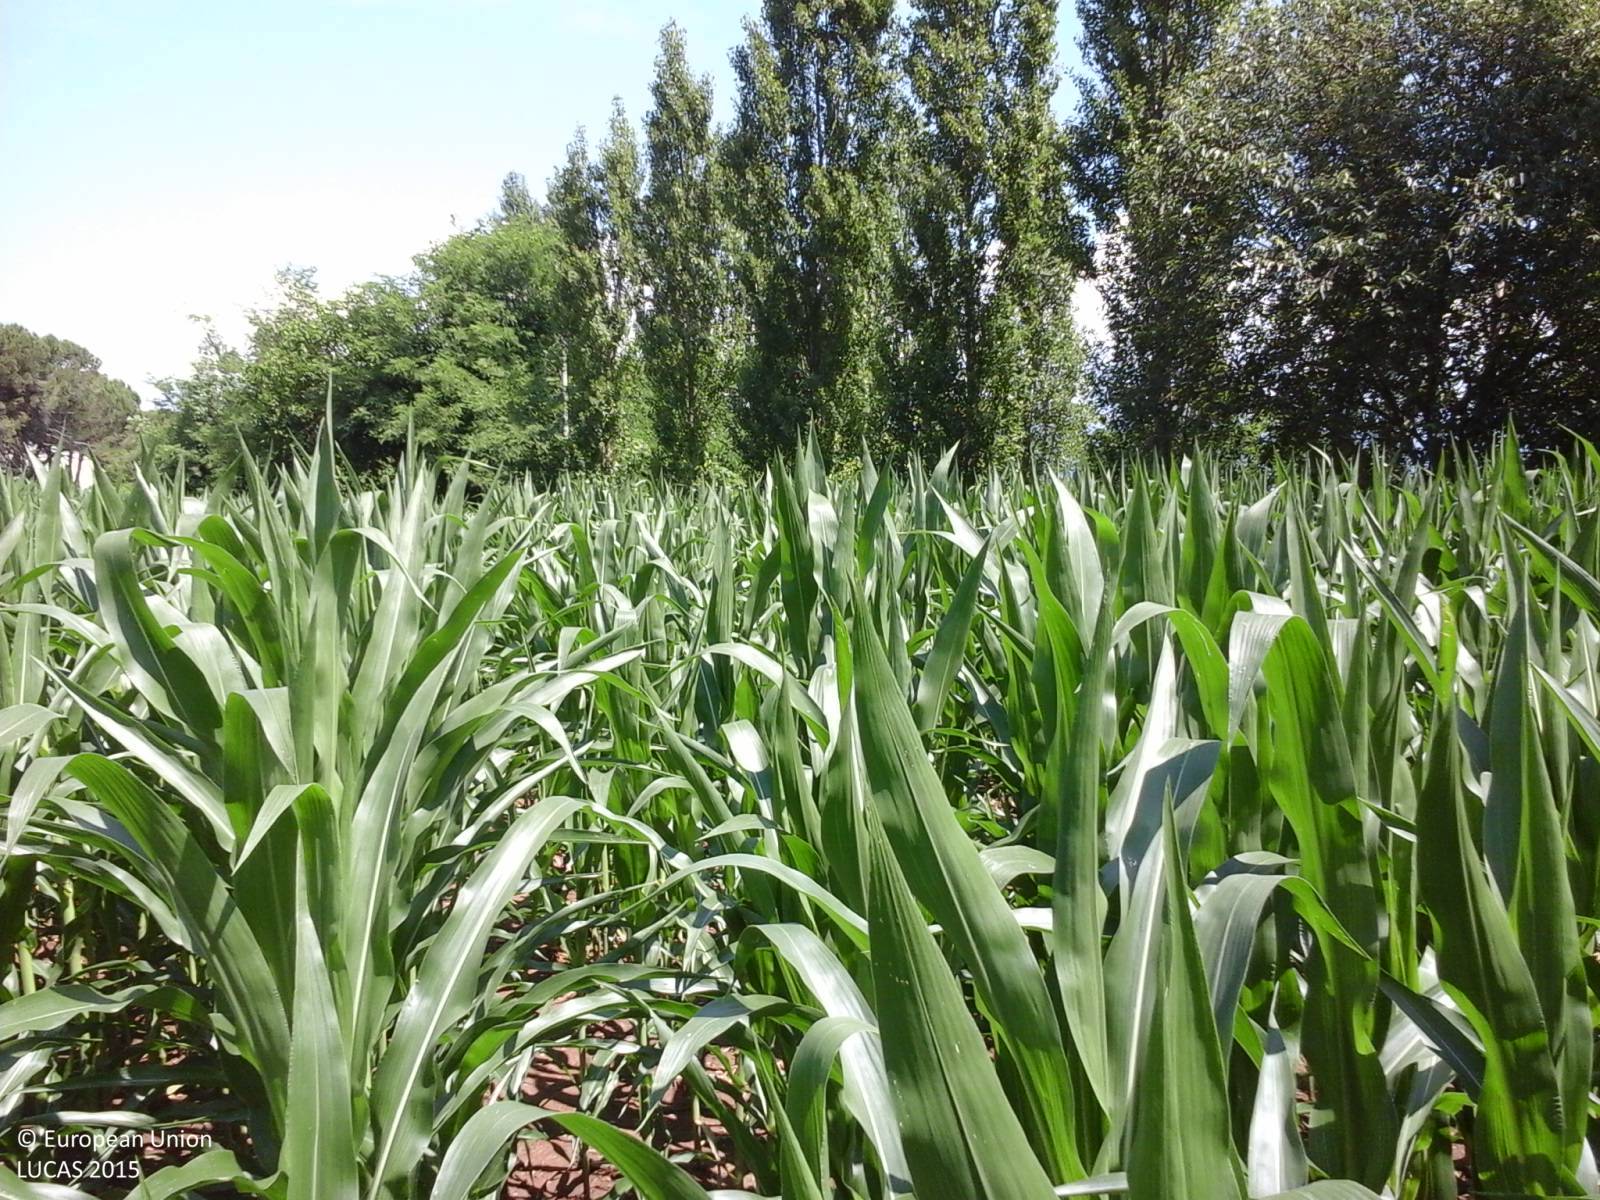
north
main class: Cropland
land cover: Maize
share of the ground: > 75 %
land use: Agriculture (excluding fallow land and kitchen gardens)
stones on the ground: < 10 %
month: June
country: IT
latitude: 46.1405
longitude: 13.2199
